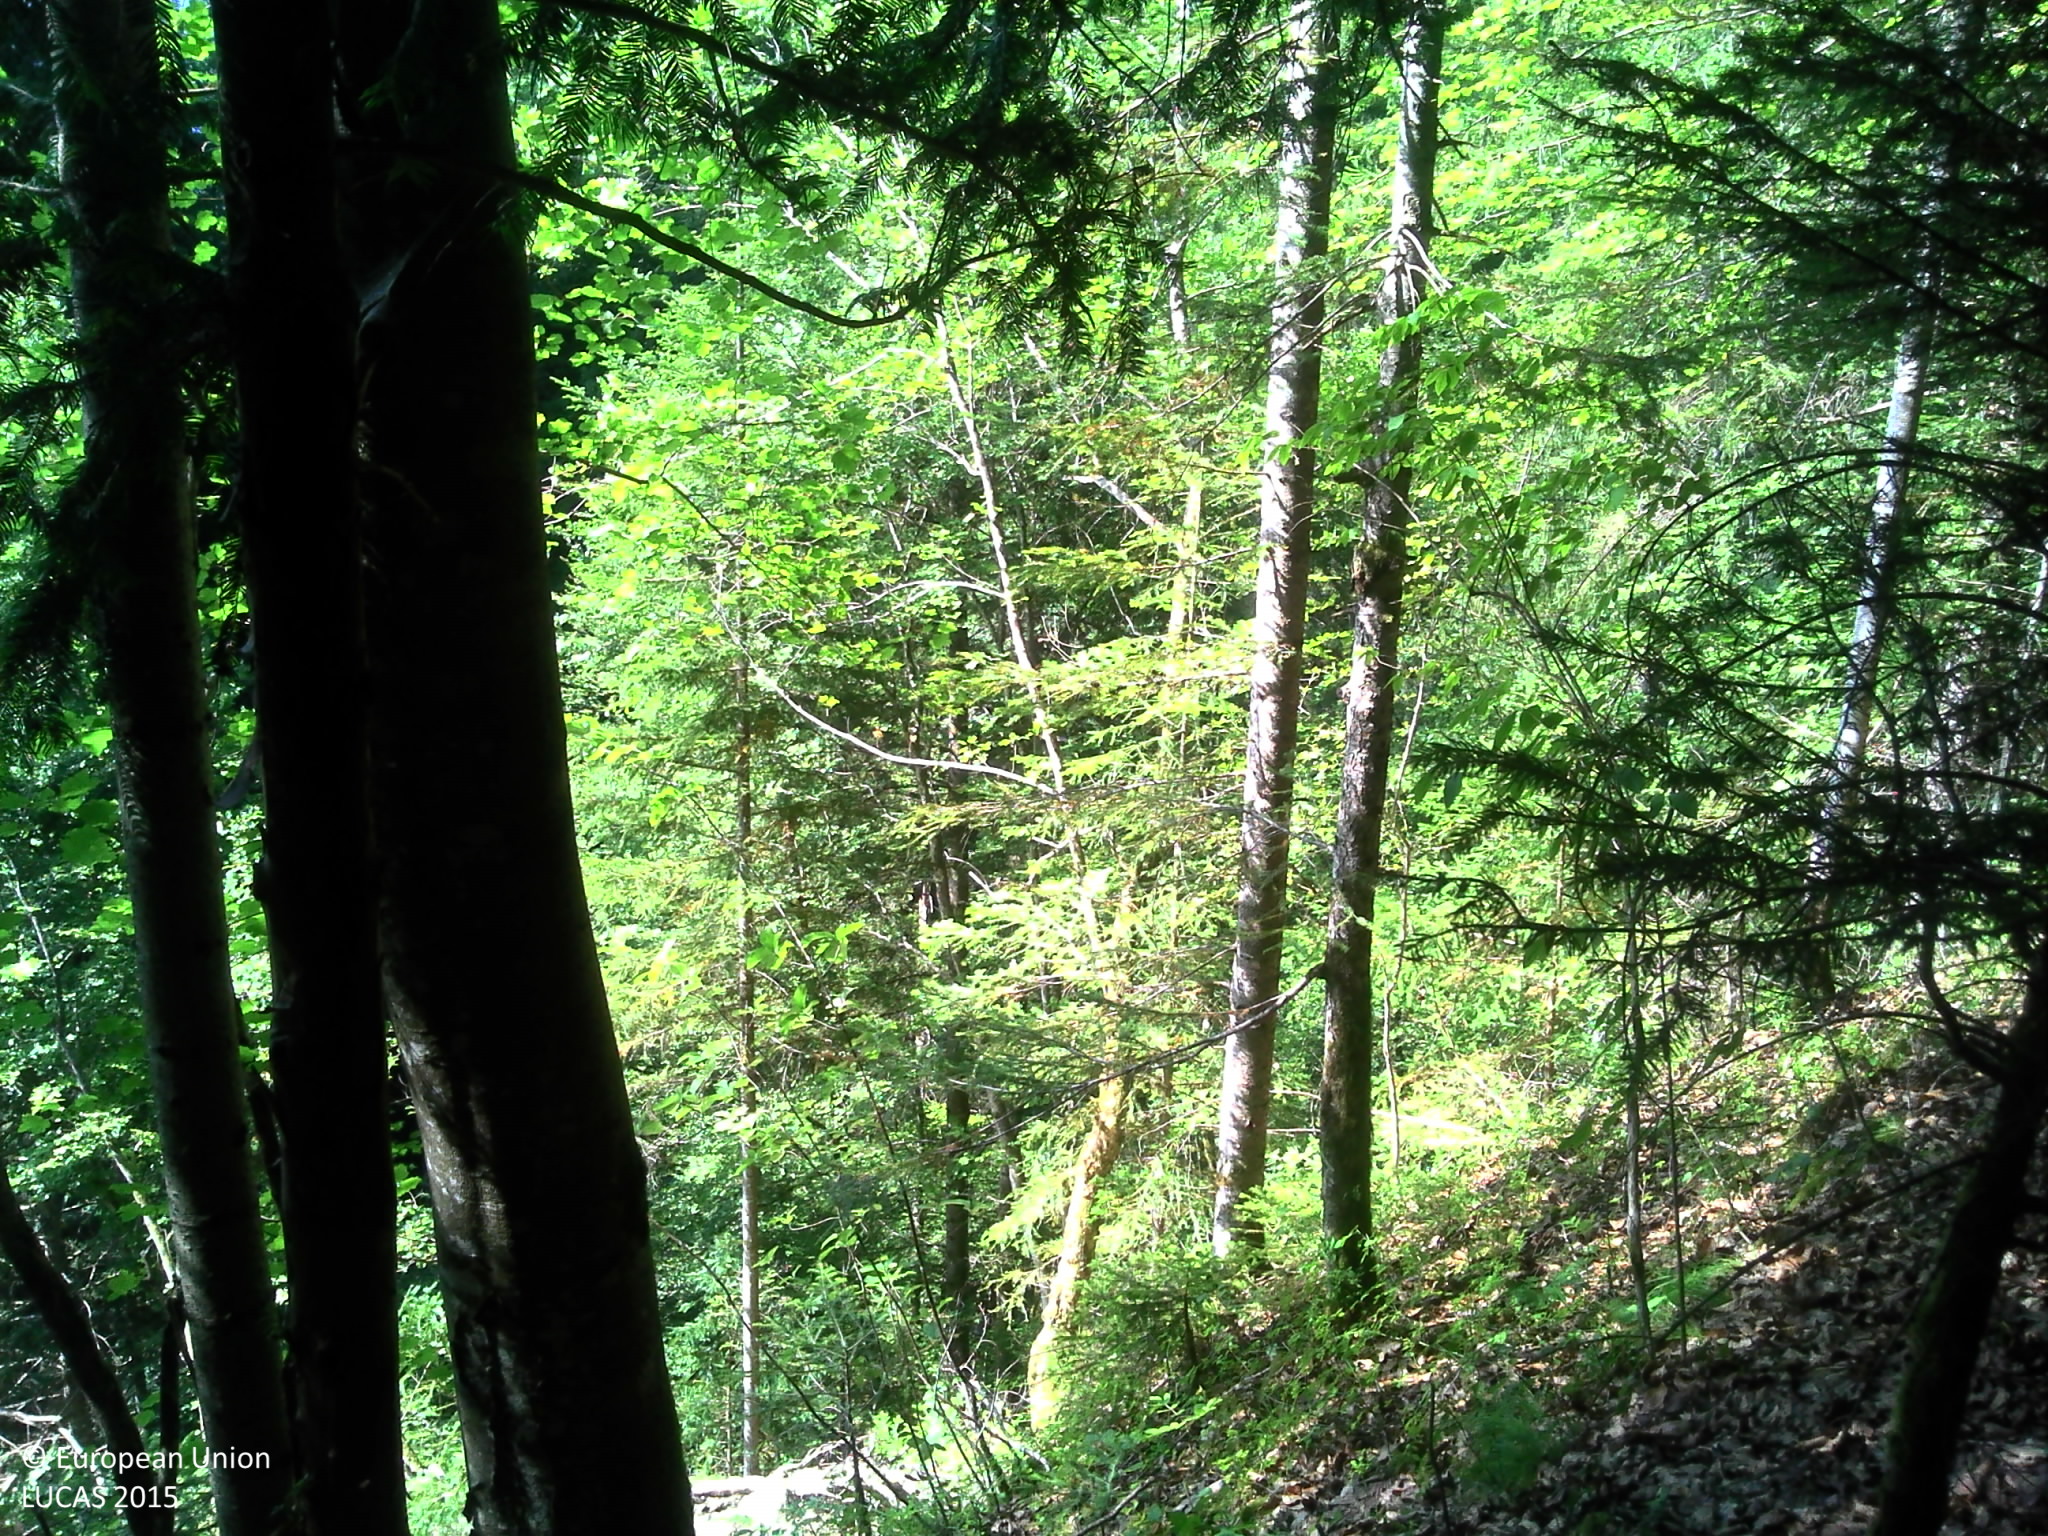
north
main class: Woodland
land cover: Spruce dominated mixed woodland
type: mountainous beech forest
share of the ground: > 75 %
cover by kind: broadleaved forest trees 40 %, coniferous forest trees 35 %, herbaceous plants 20 %, lichens and mosses 5 %
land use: Forestry
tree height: > 5 m
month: July
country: FR
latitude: 45.7288
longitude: 6.3164
